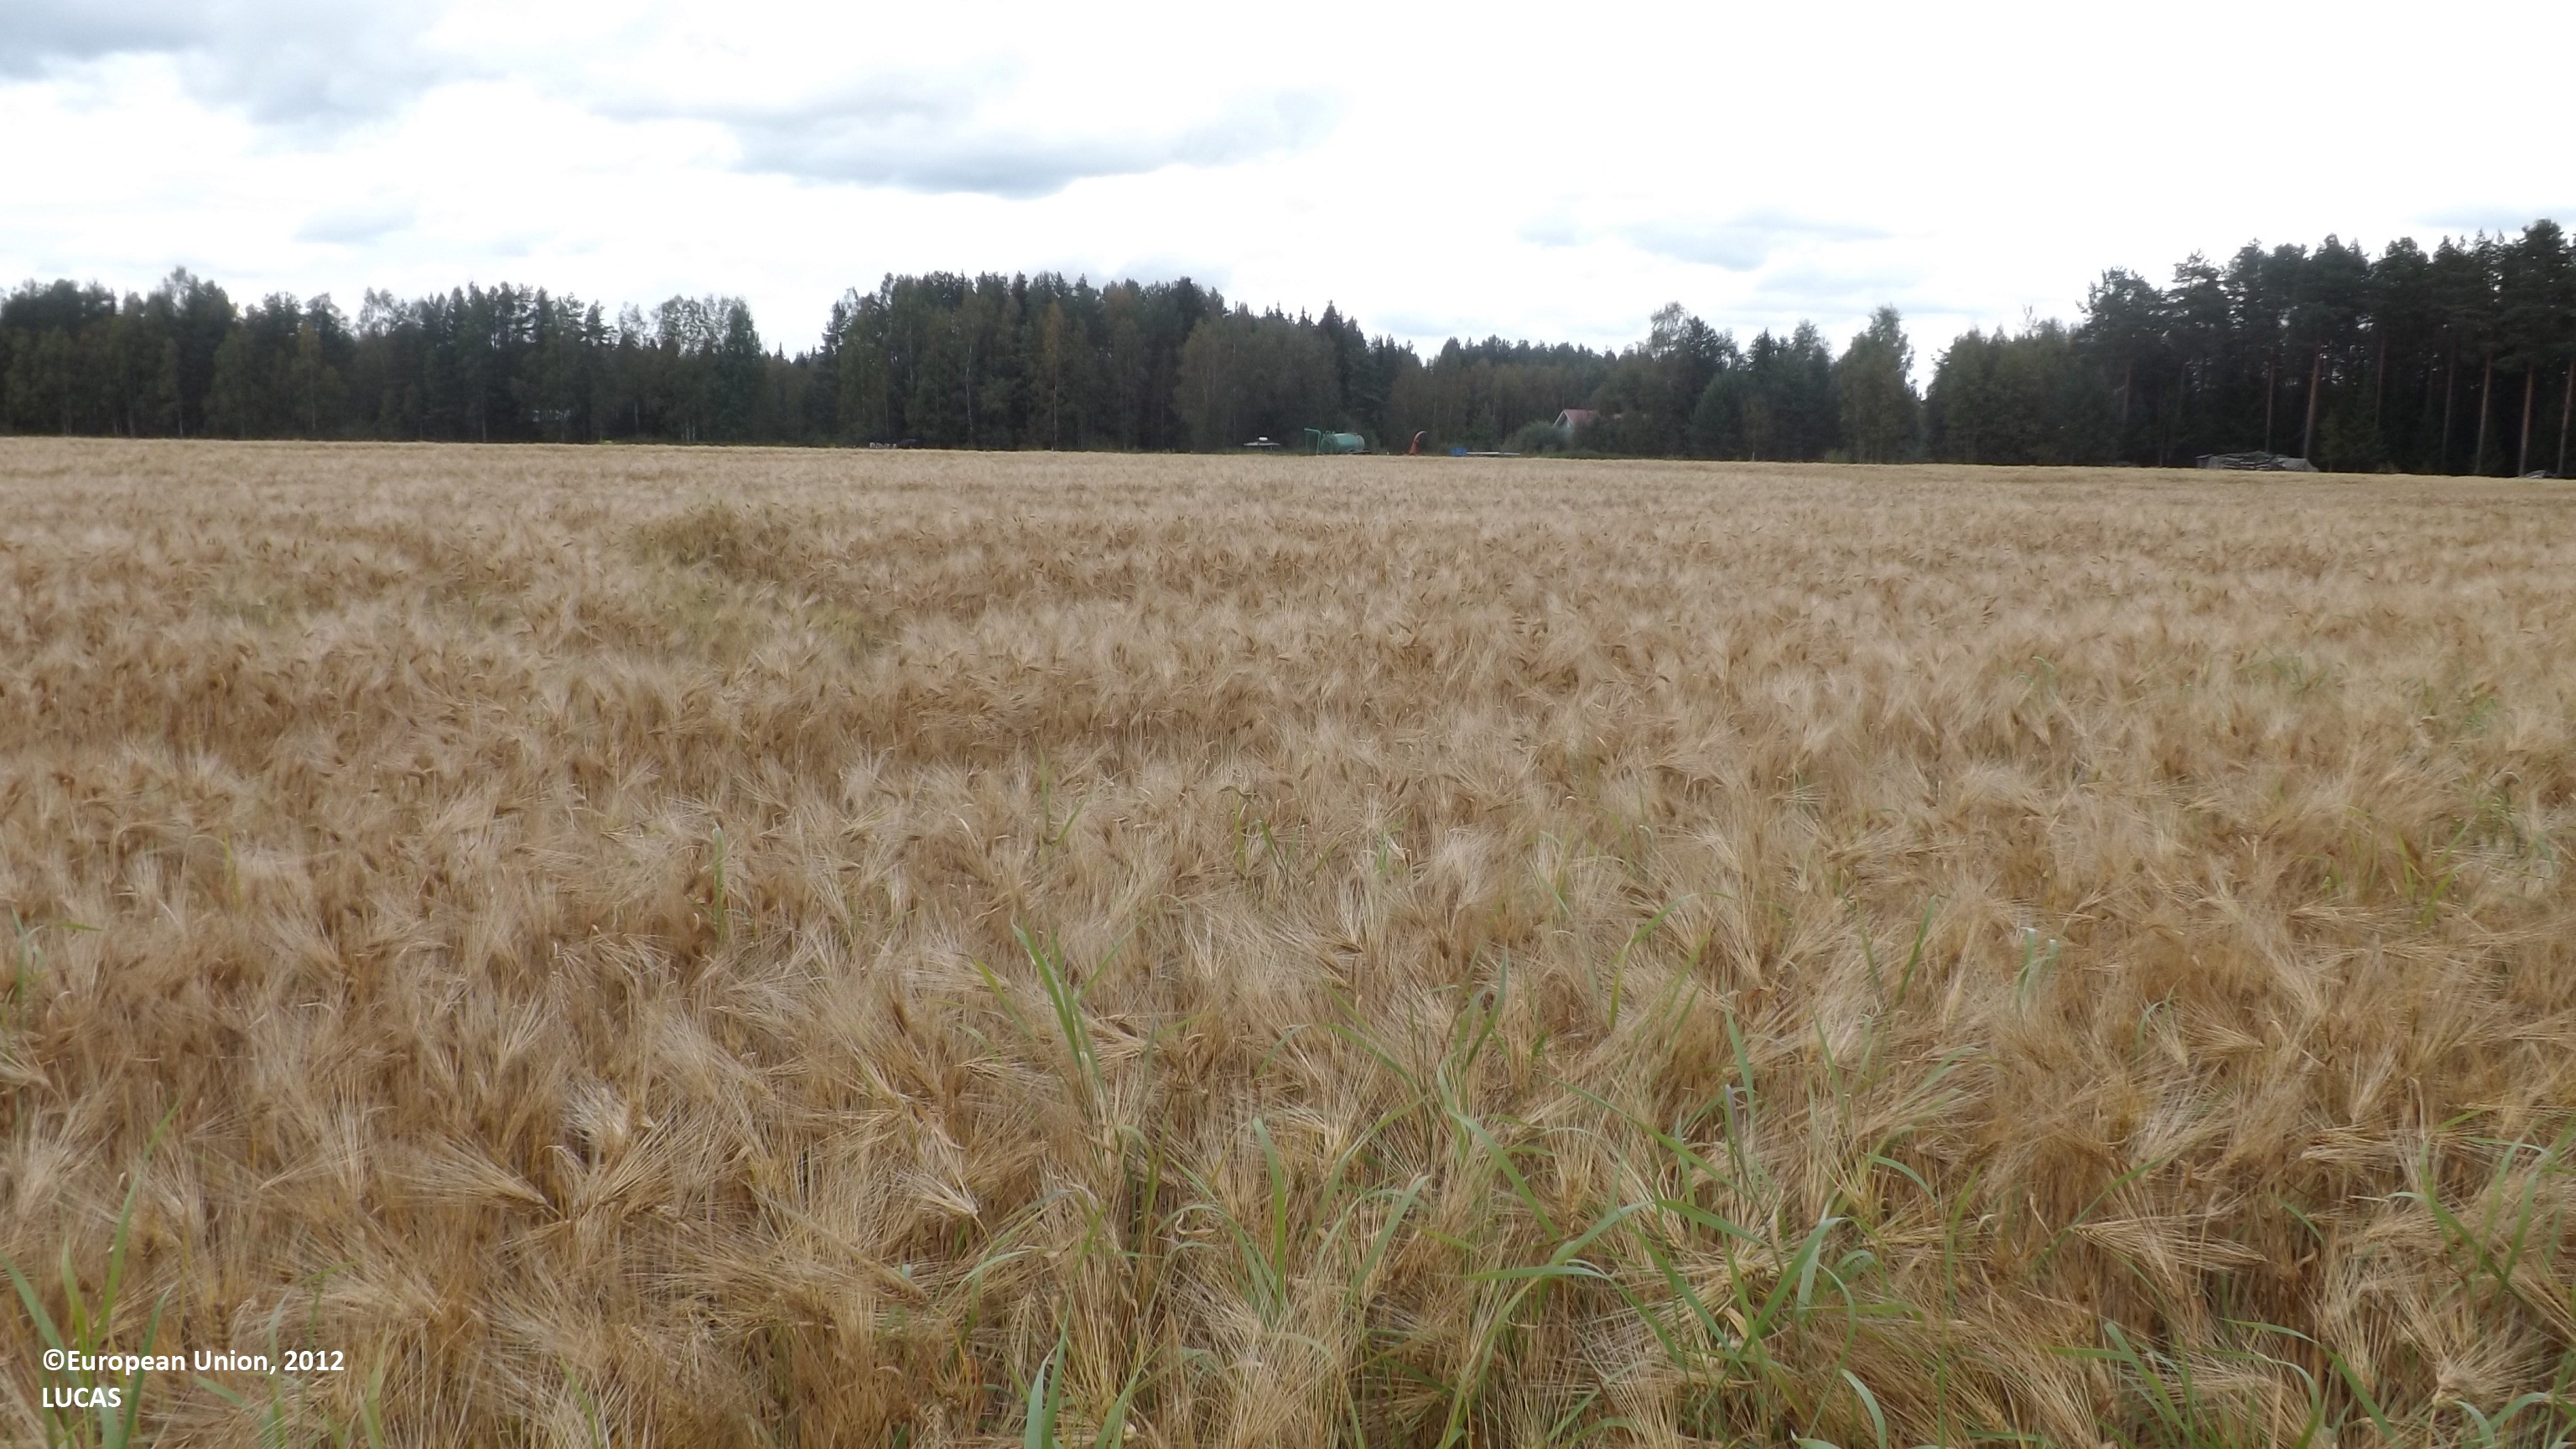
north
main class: Cropland
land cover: Barley
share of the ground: > 75 %
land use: Agriculture (excluding fallow land and kitchen gardens)
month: August
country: FI
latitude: 63.9039
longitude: 23.9829
